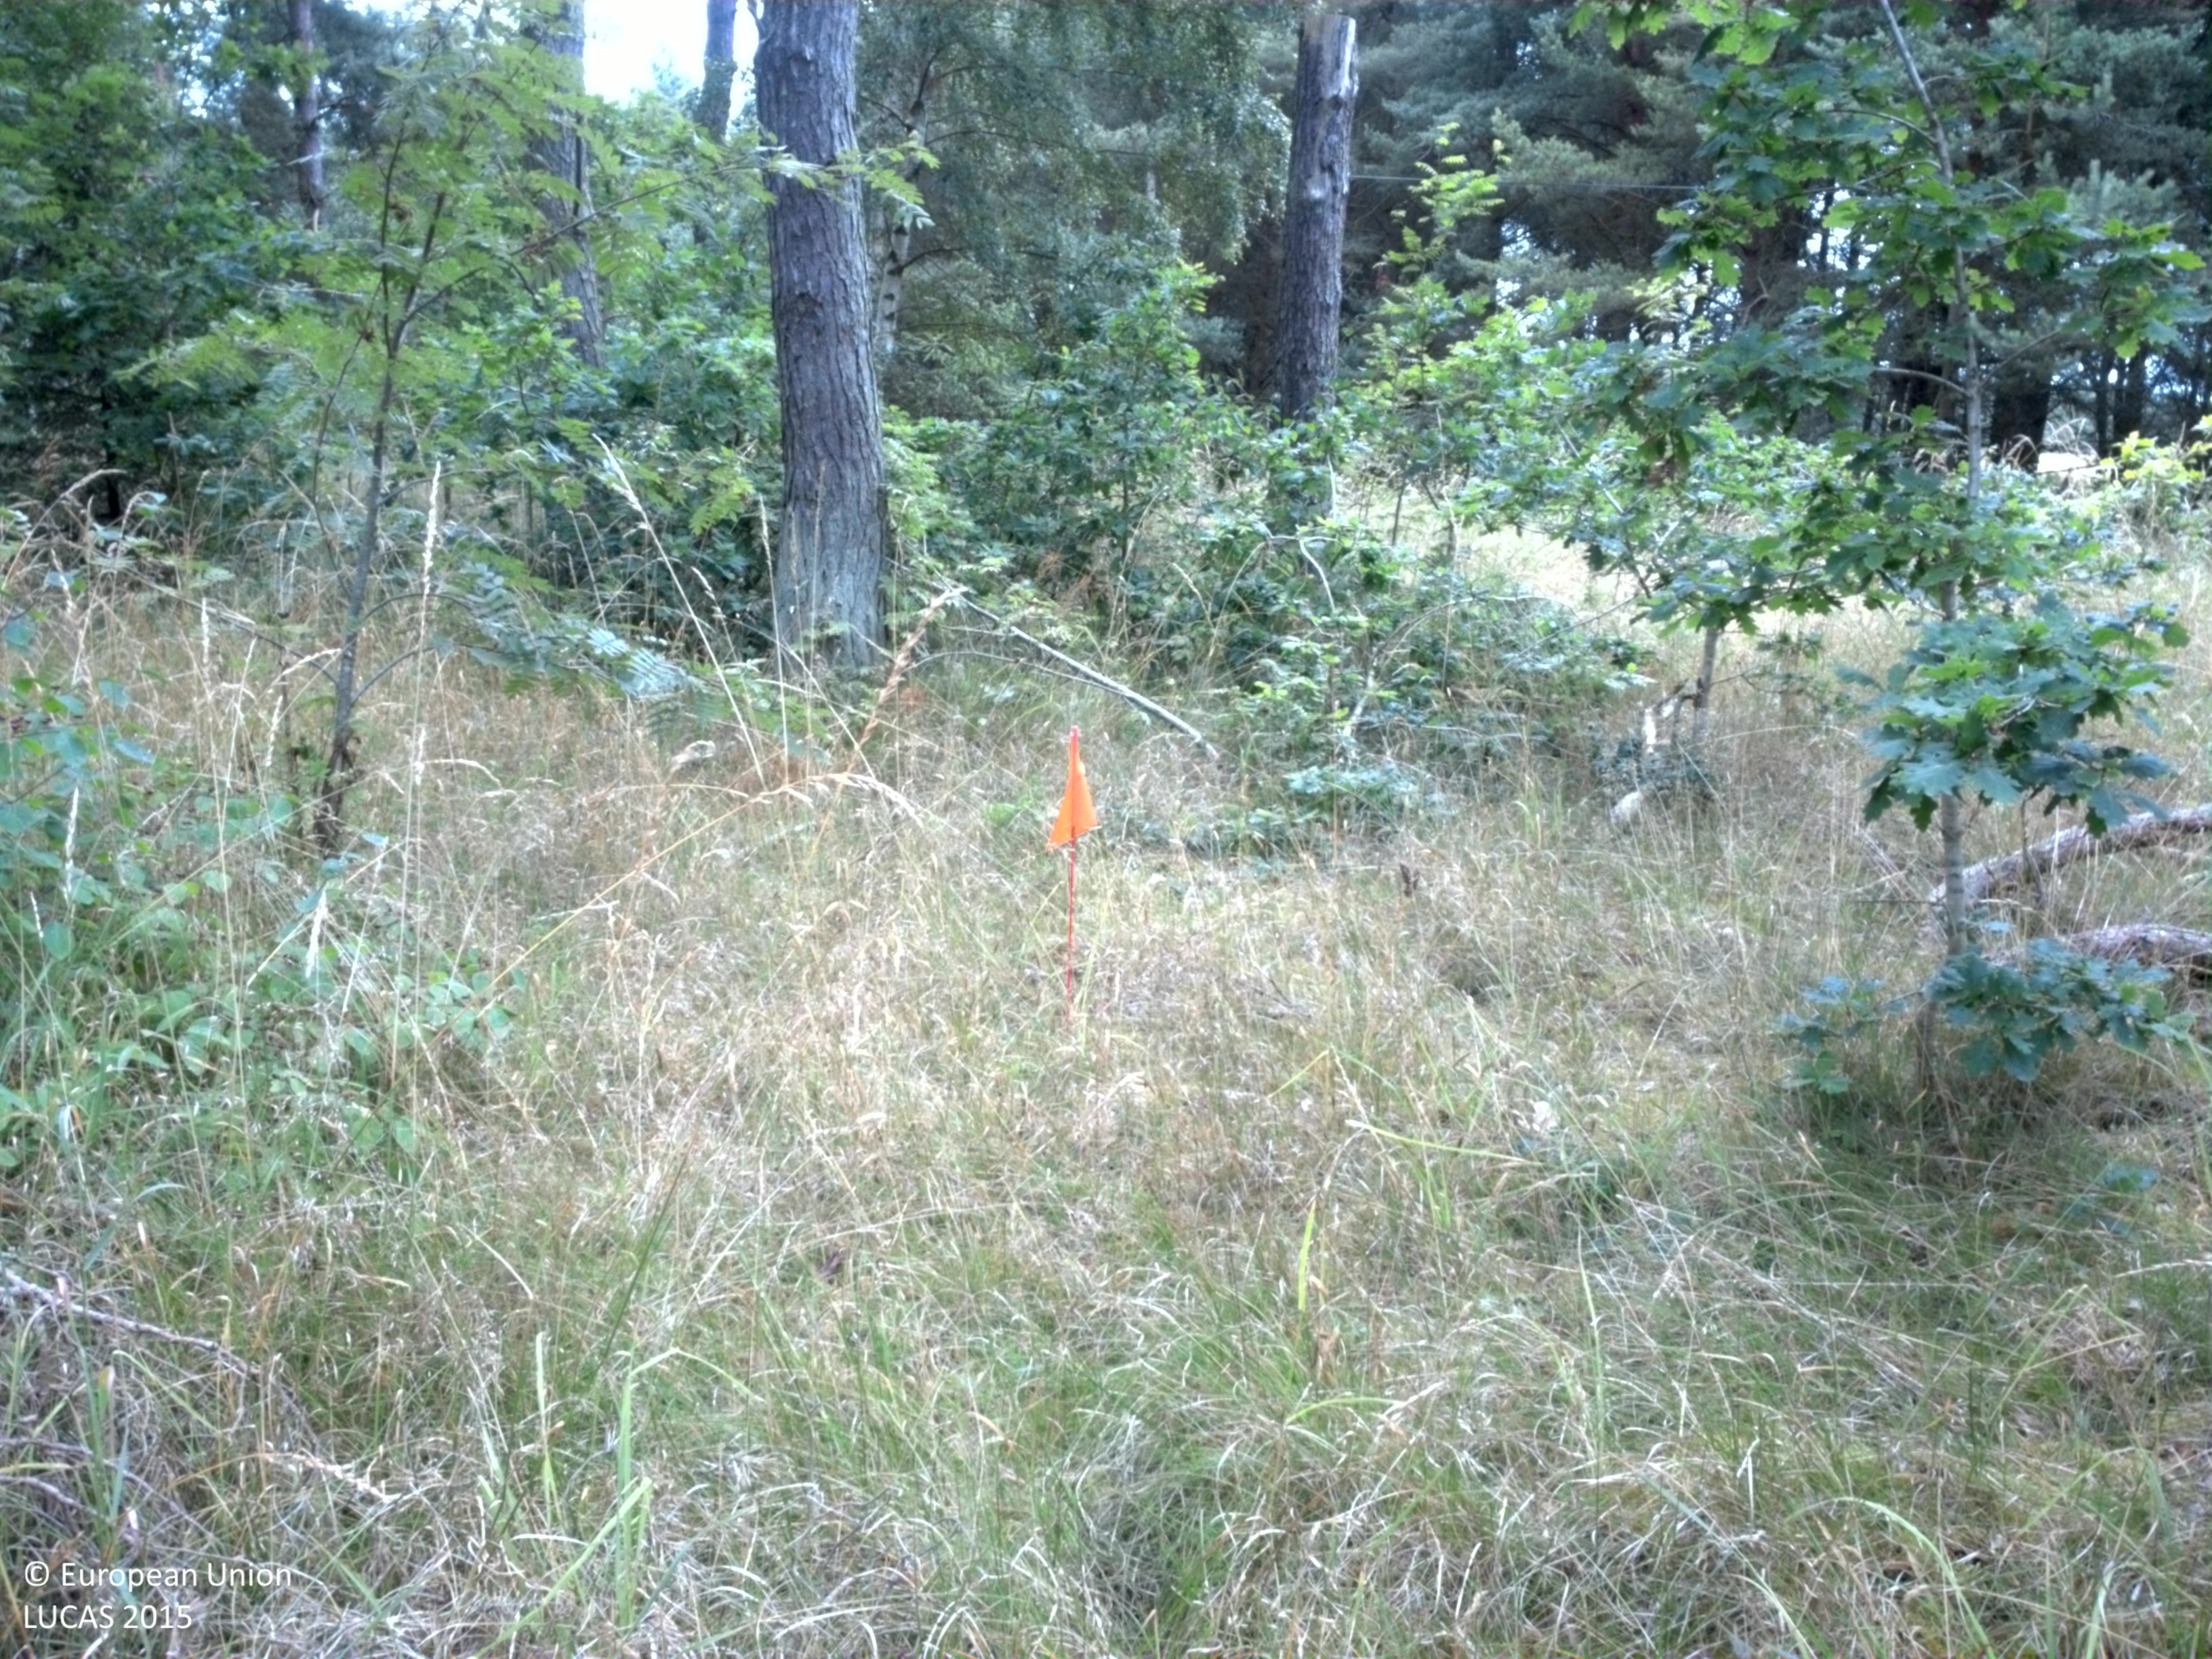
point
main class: Woodland
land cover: Pine dominated mixed woodland
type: hemiboreal forest and nemoral coniferous forest and mixed broadleaved-coniferous forest
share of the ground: > 75 %
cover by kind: coniferous forest trees 50 %, broadleaved forest trees 25 %, herbaceous plants 20 %, shrubs 5 %
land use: Forestry
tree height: > 5 m
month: July
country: SE
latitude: 57.2328
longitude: 18.6749
